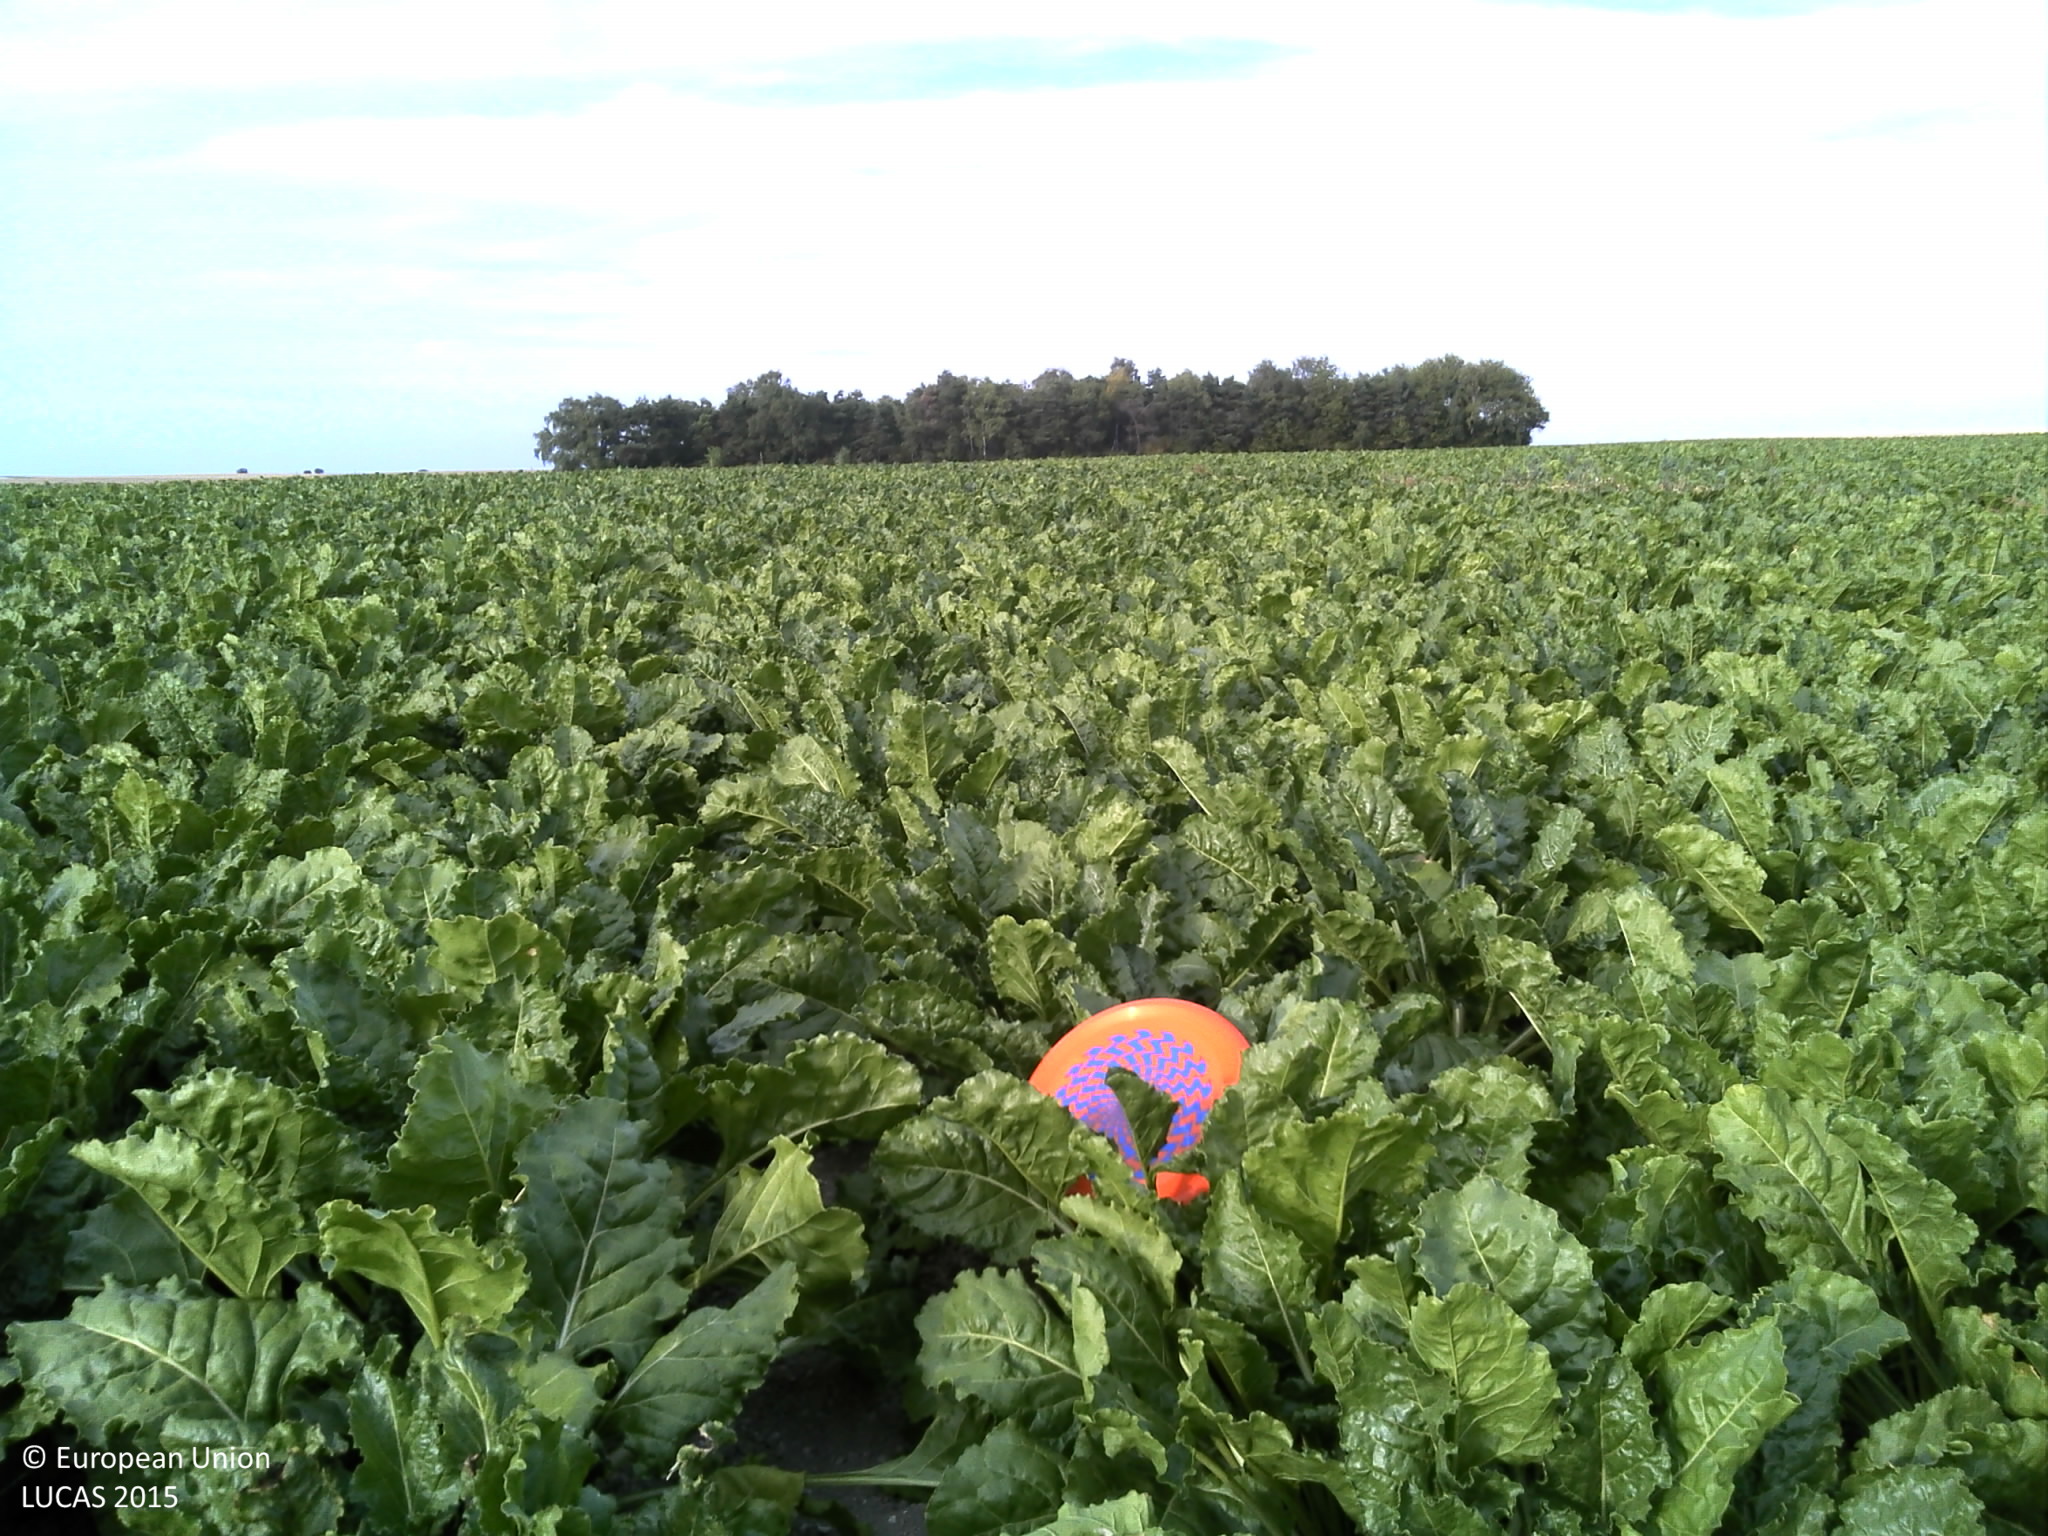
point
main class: Cropland
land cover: Sugar beet
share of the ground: 50 - 75 %
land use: Agriculture (excluding fallow land and kitchen gardens)
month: August
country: FR
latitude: 48.9621
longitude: 4.7114
